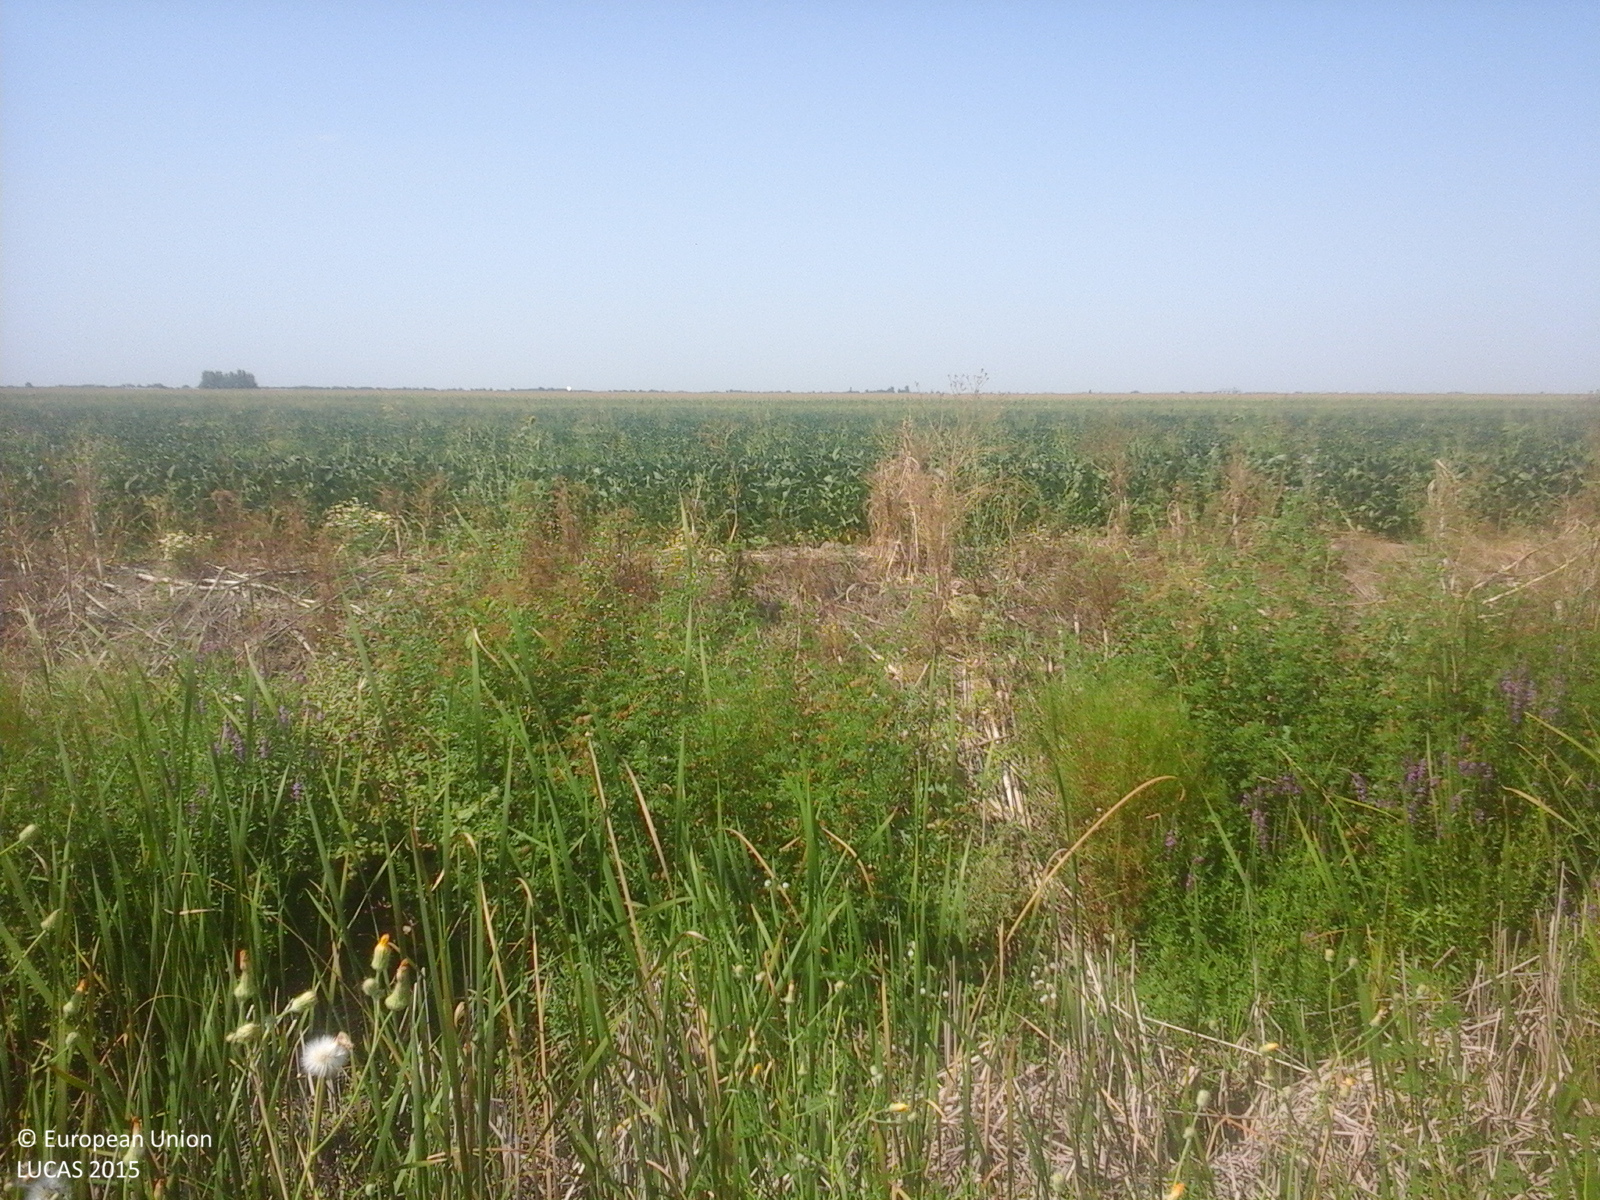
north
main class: Cropland
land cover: Soya
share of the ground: > 75 %
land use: Agriculture (excluding fallow land and kitchen gardens)
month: July
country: RO
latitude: 44.1926
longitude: 27.1835
